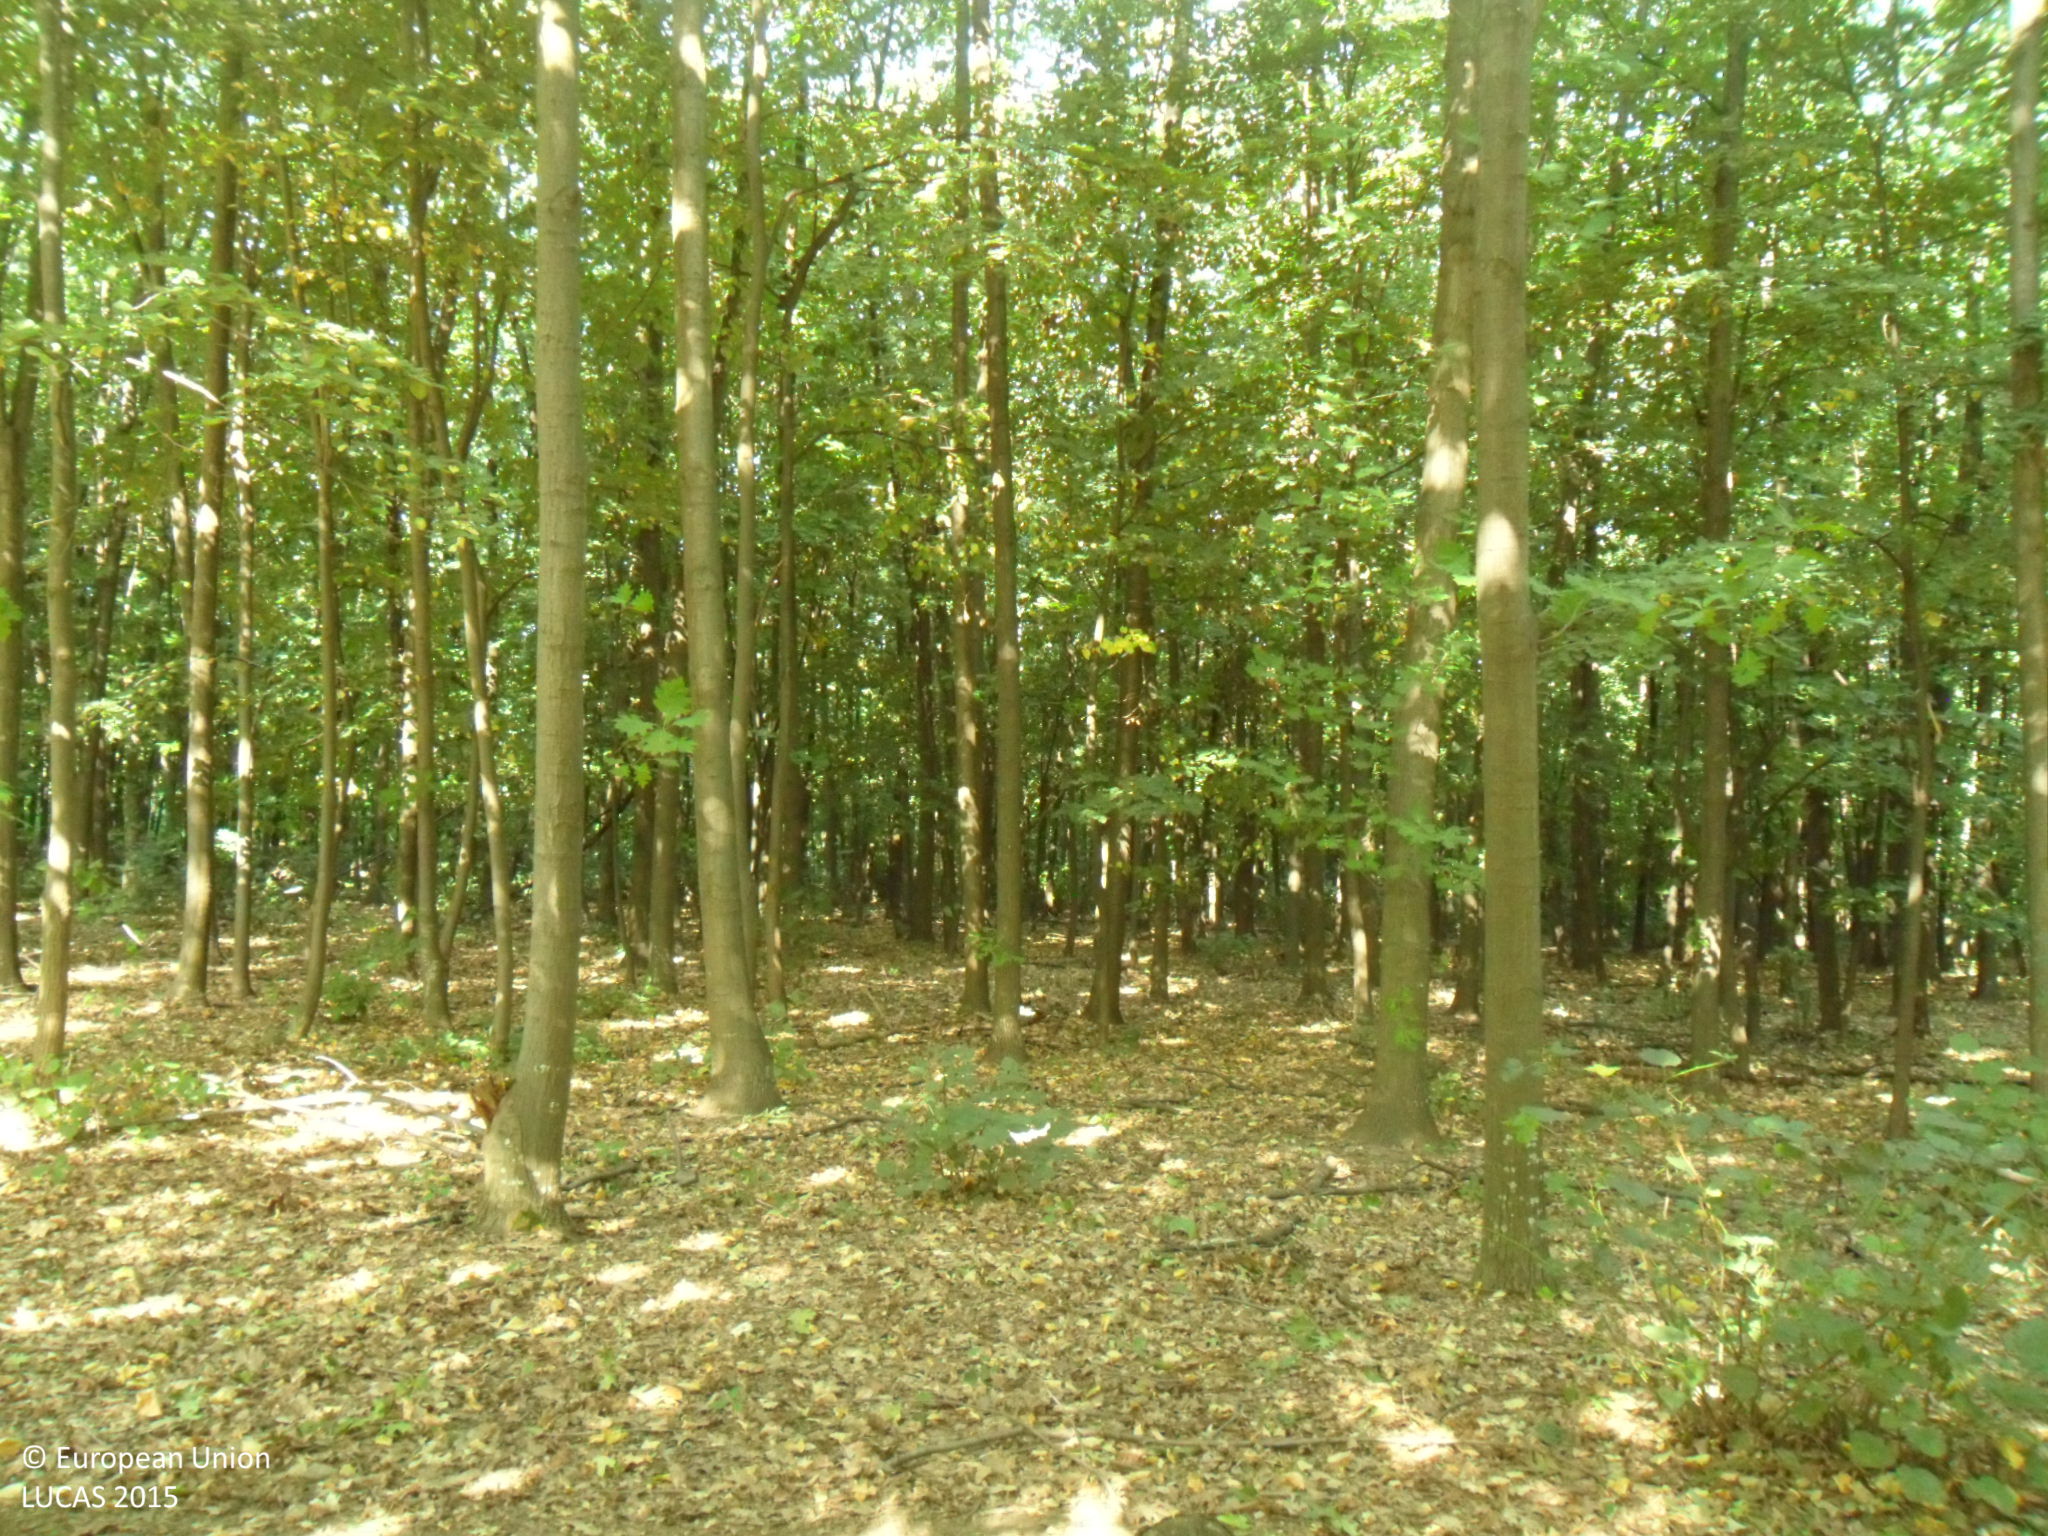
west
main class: Woodland
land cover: Broadleaved woodland
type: beech forest
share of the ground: > 75 %
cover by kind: broadleaved forest trees 95 %, unconsolidated bare surface 5 %
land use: Forestry
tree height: > 5 m
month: September
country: BG
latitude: 43.9117
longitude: 26.4328
